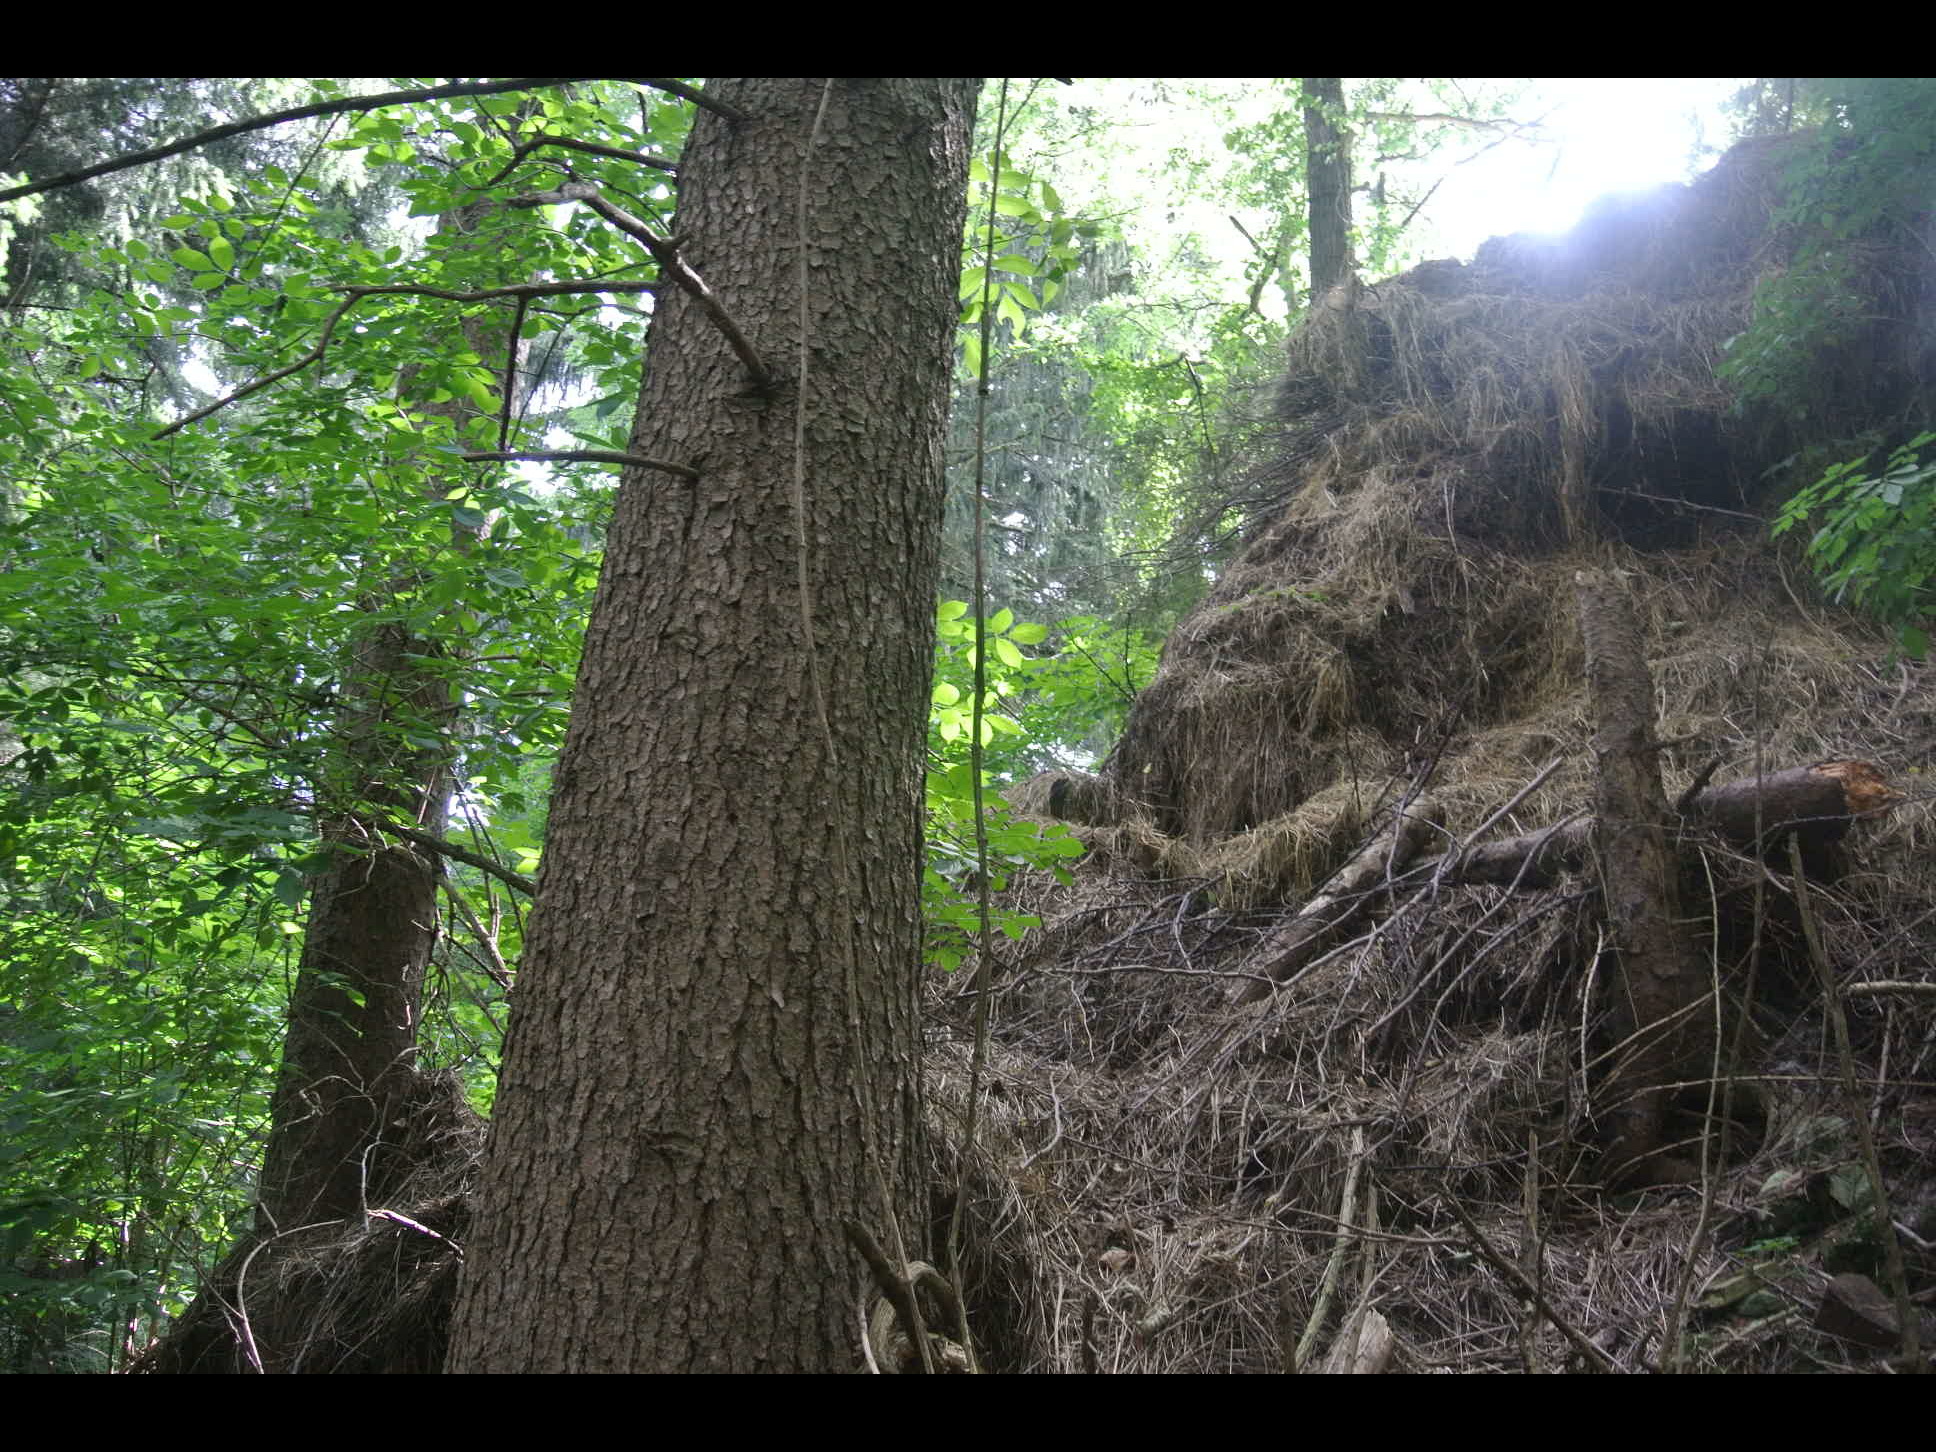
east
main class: Woodland
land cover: Spruce dominated mixed woodland
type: alpine coniferous forest
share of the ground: > 75 %
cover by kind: coniferous forest trees 70 %, broadleaved forest trees 25 %, lichens and mosses 5 %
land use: Forestry
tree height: > 5 m
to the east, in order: Spruce dominated mixed woodland; Grassland without tree/shrub cover; Spruce dominated mixed woodland; Fences; Spruce dominated mixed woodland; Tracks; Fences; Grassland without tree/shrub cover
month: July
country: AT
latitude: 48.0022
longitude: 15.3763
